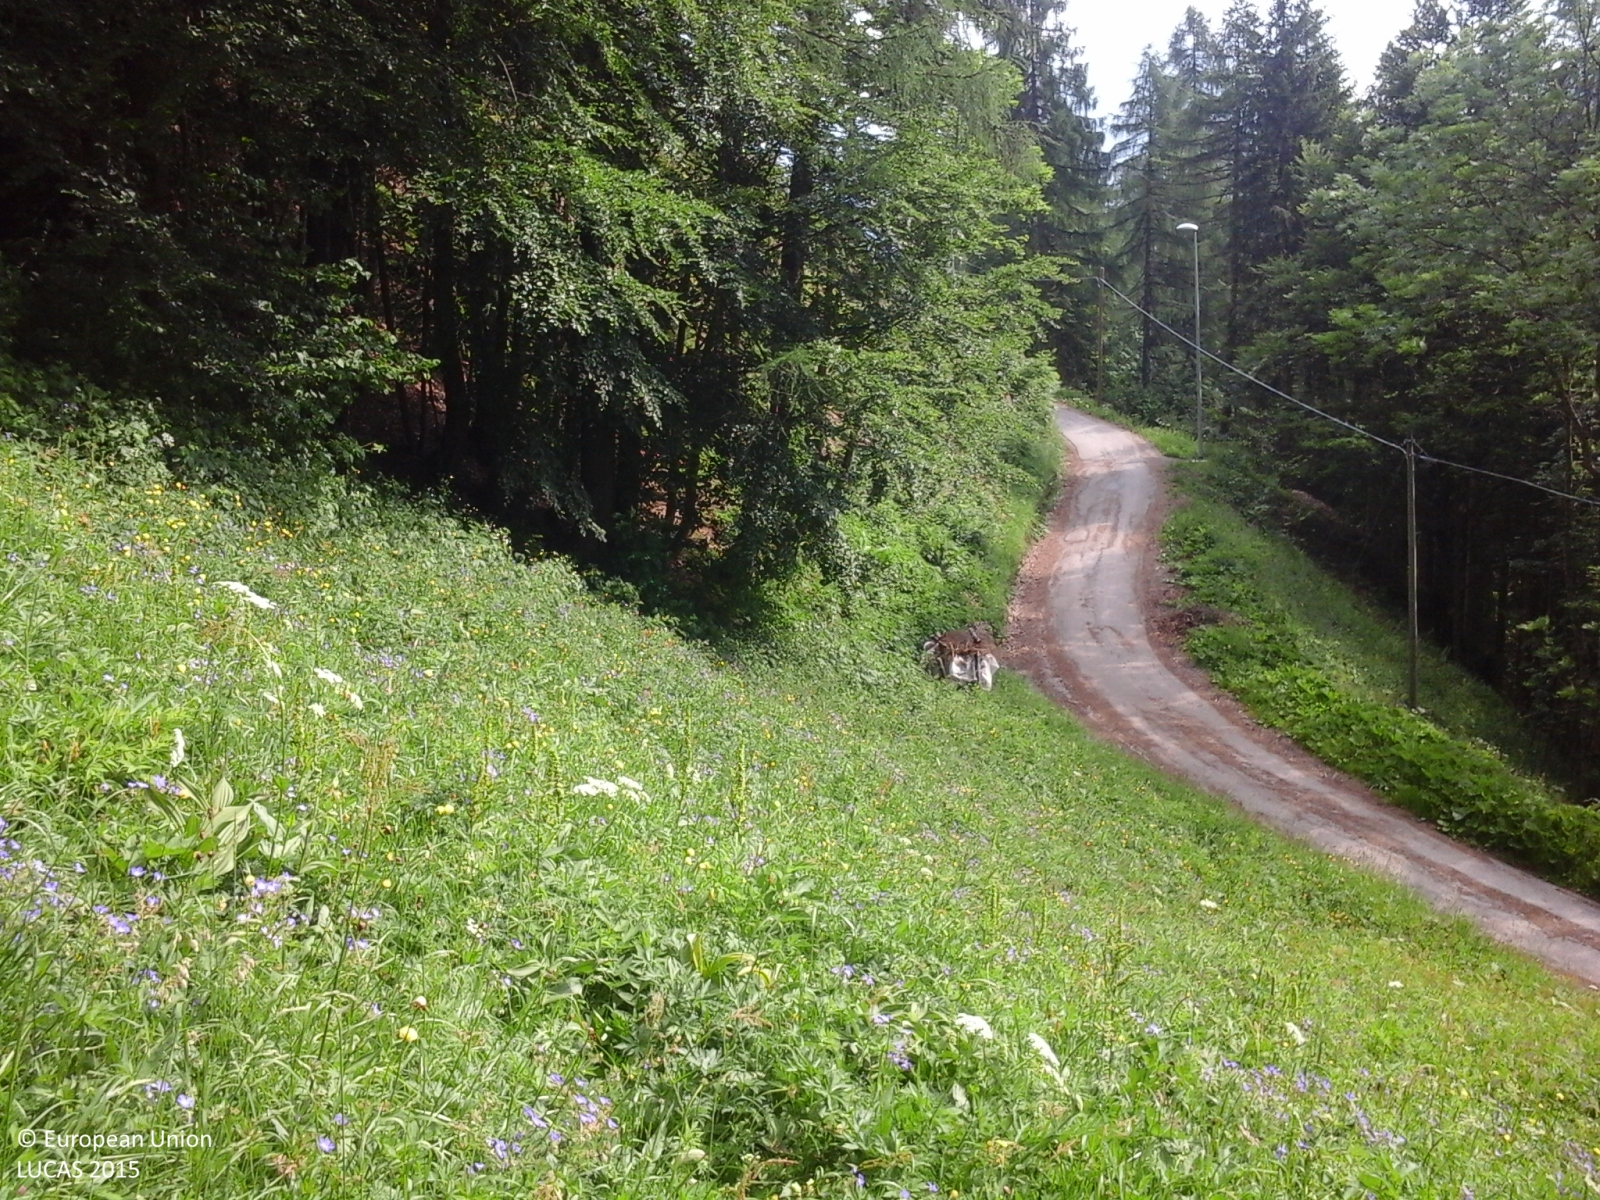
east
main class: Grassland
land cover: Grassland with sparse tree/shrub cover
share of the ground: > 75 %
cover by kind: herbaceous plants 85 %, shrubs 10 %, coniferous forest trees 5 %
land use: Agriculture (excluding fallow land and kitchen gardens)
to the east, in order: Grassland with sparse tree/shrub cover; Grassland without tree/shrub cover; Spruce dominated coniferous woodland; Tracks; Spruce dominated coniferous woodland; Grassland without tree/shrub cover; Tracks; Shrubland with sparse tree cover; Spruce dominated coniferous woodland; Shrubland with sparse tree cover
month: June
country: IT
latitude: 46.3838
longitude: 12.1429
